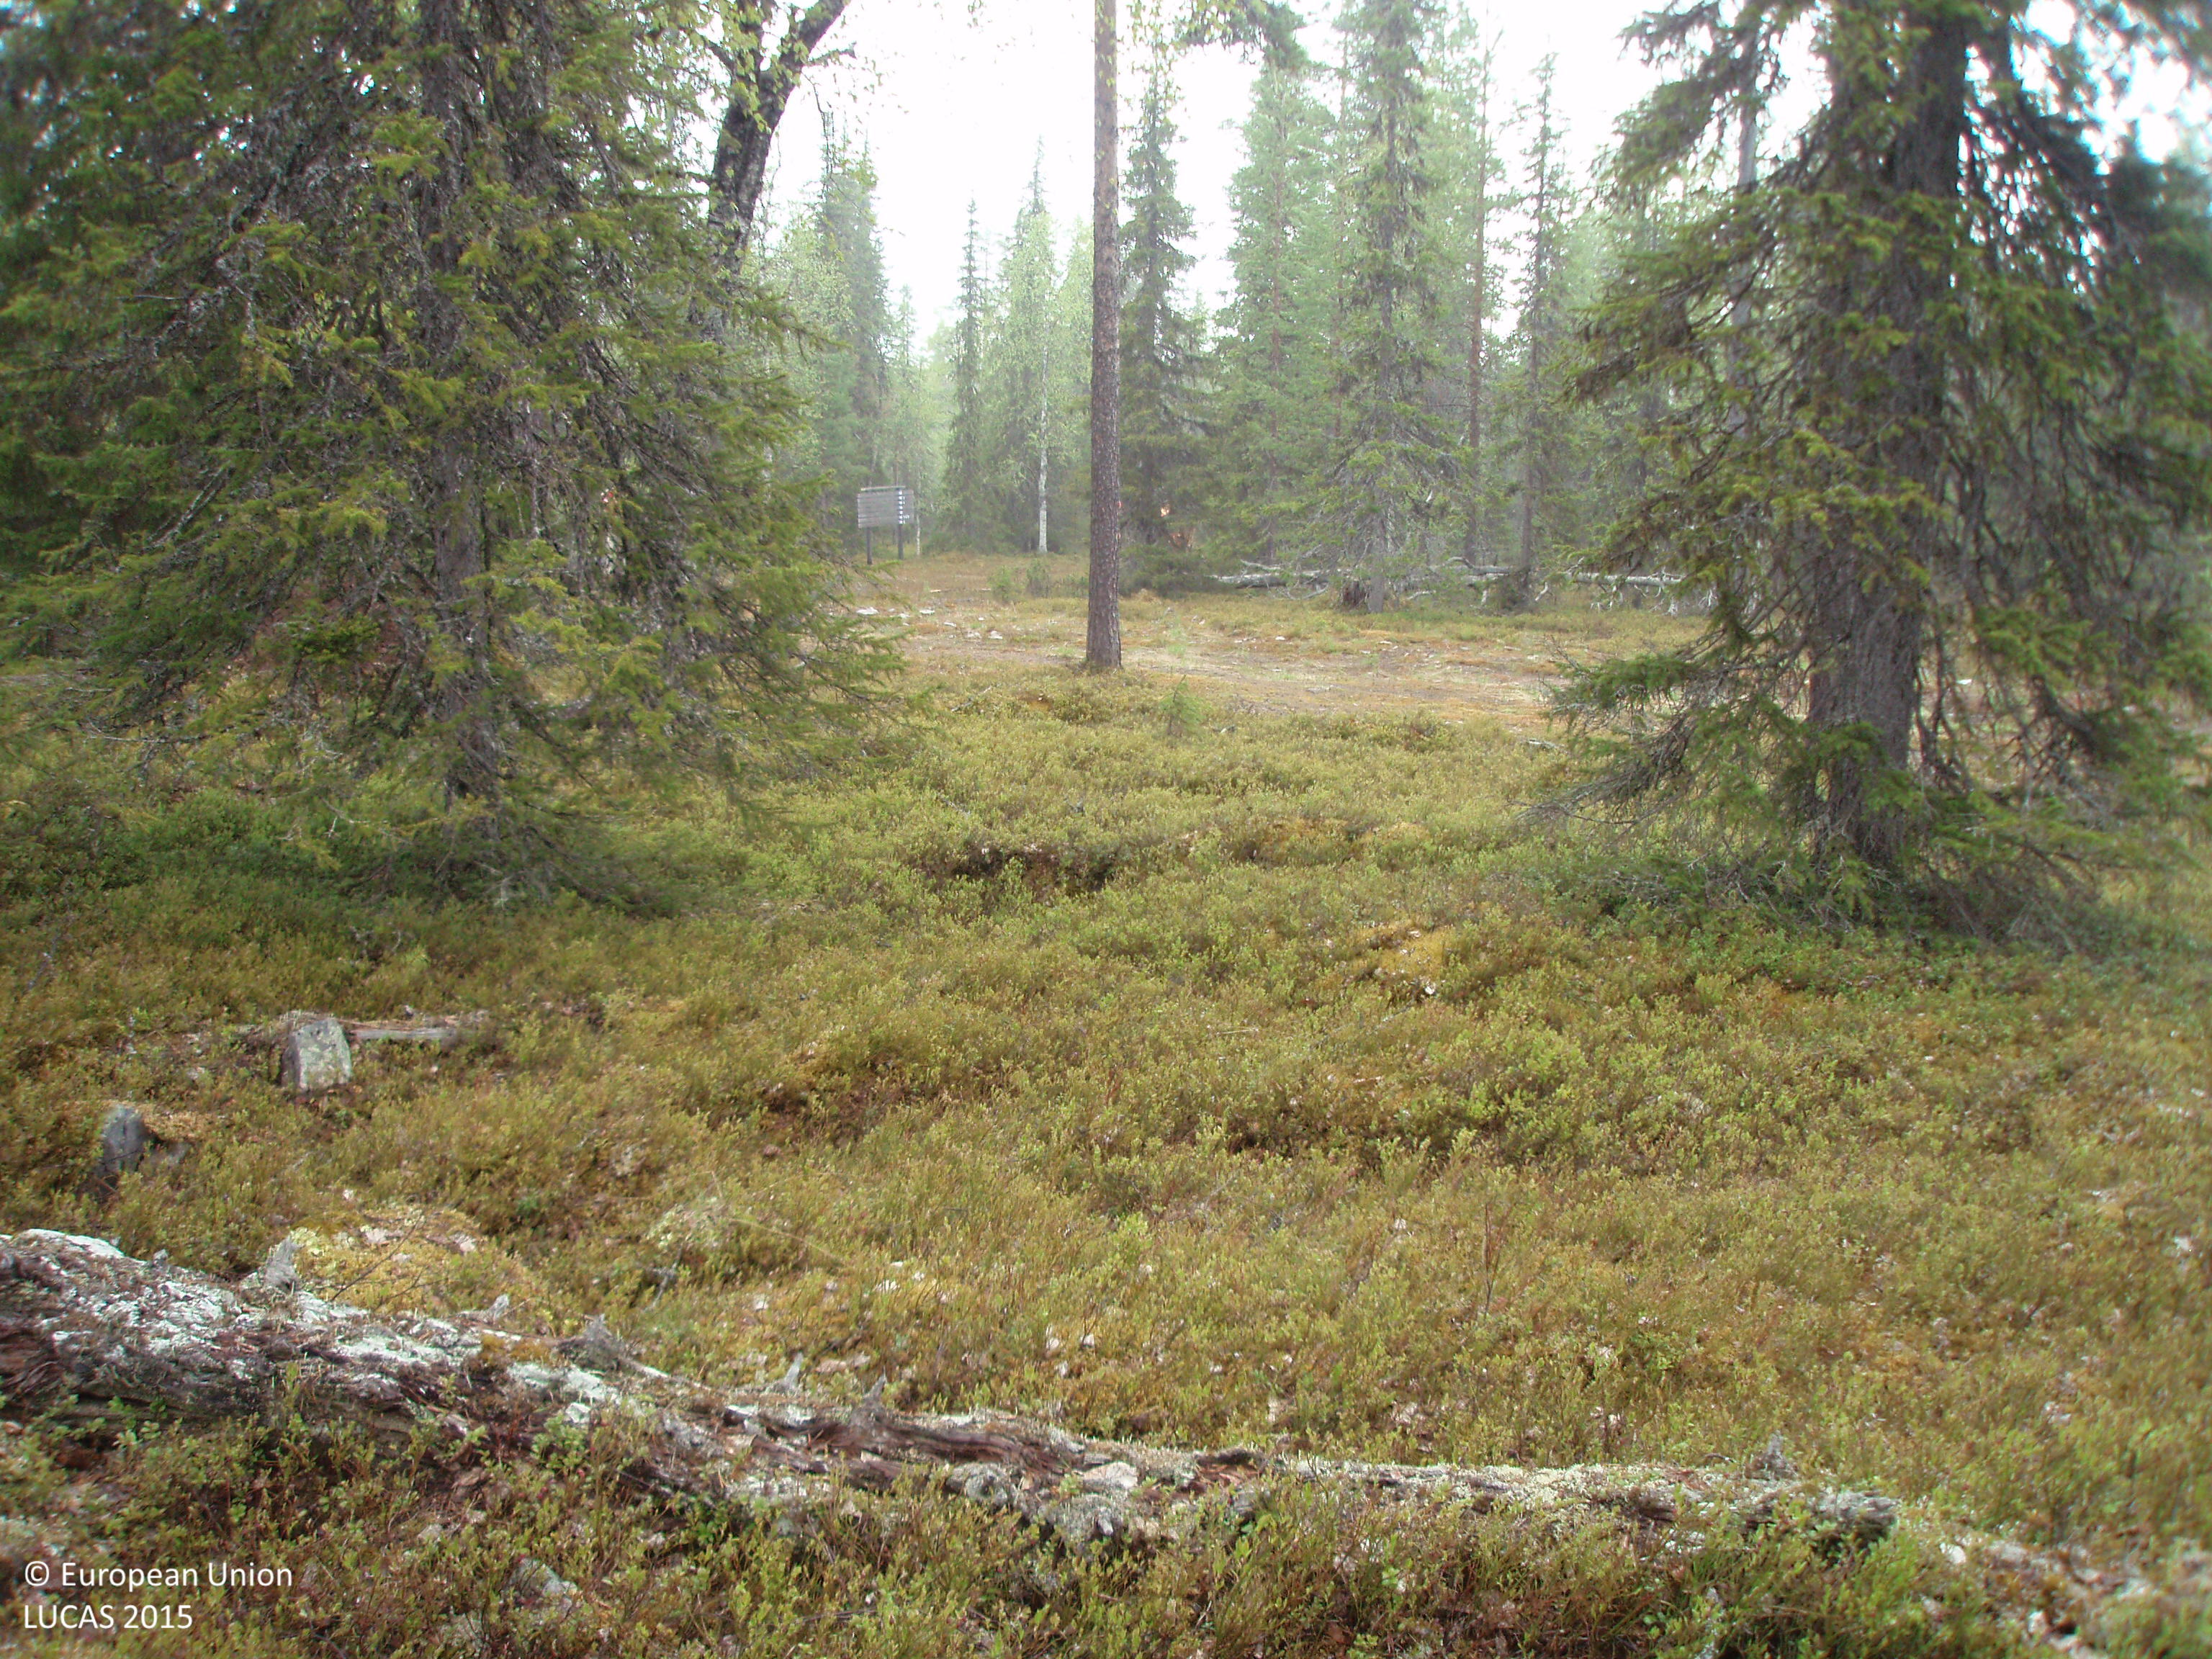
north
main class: Woodland
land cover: Other mixed woodland
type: boreal forest
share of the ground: 50 - 75 %
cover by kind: coniferous forest trees 40 %, shrubs 30 %, broadleaved forest trees 15 %, lichens and mosses 15 %
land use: Forestry
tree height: > 5 m
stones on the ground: < 10 %
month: June
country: FI
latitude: 67.1197
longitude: 26.9840
